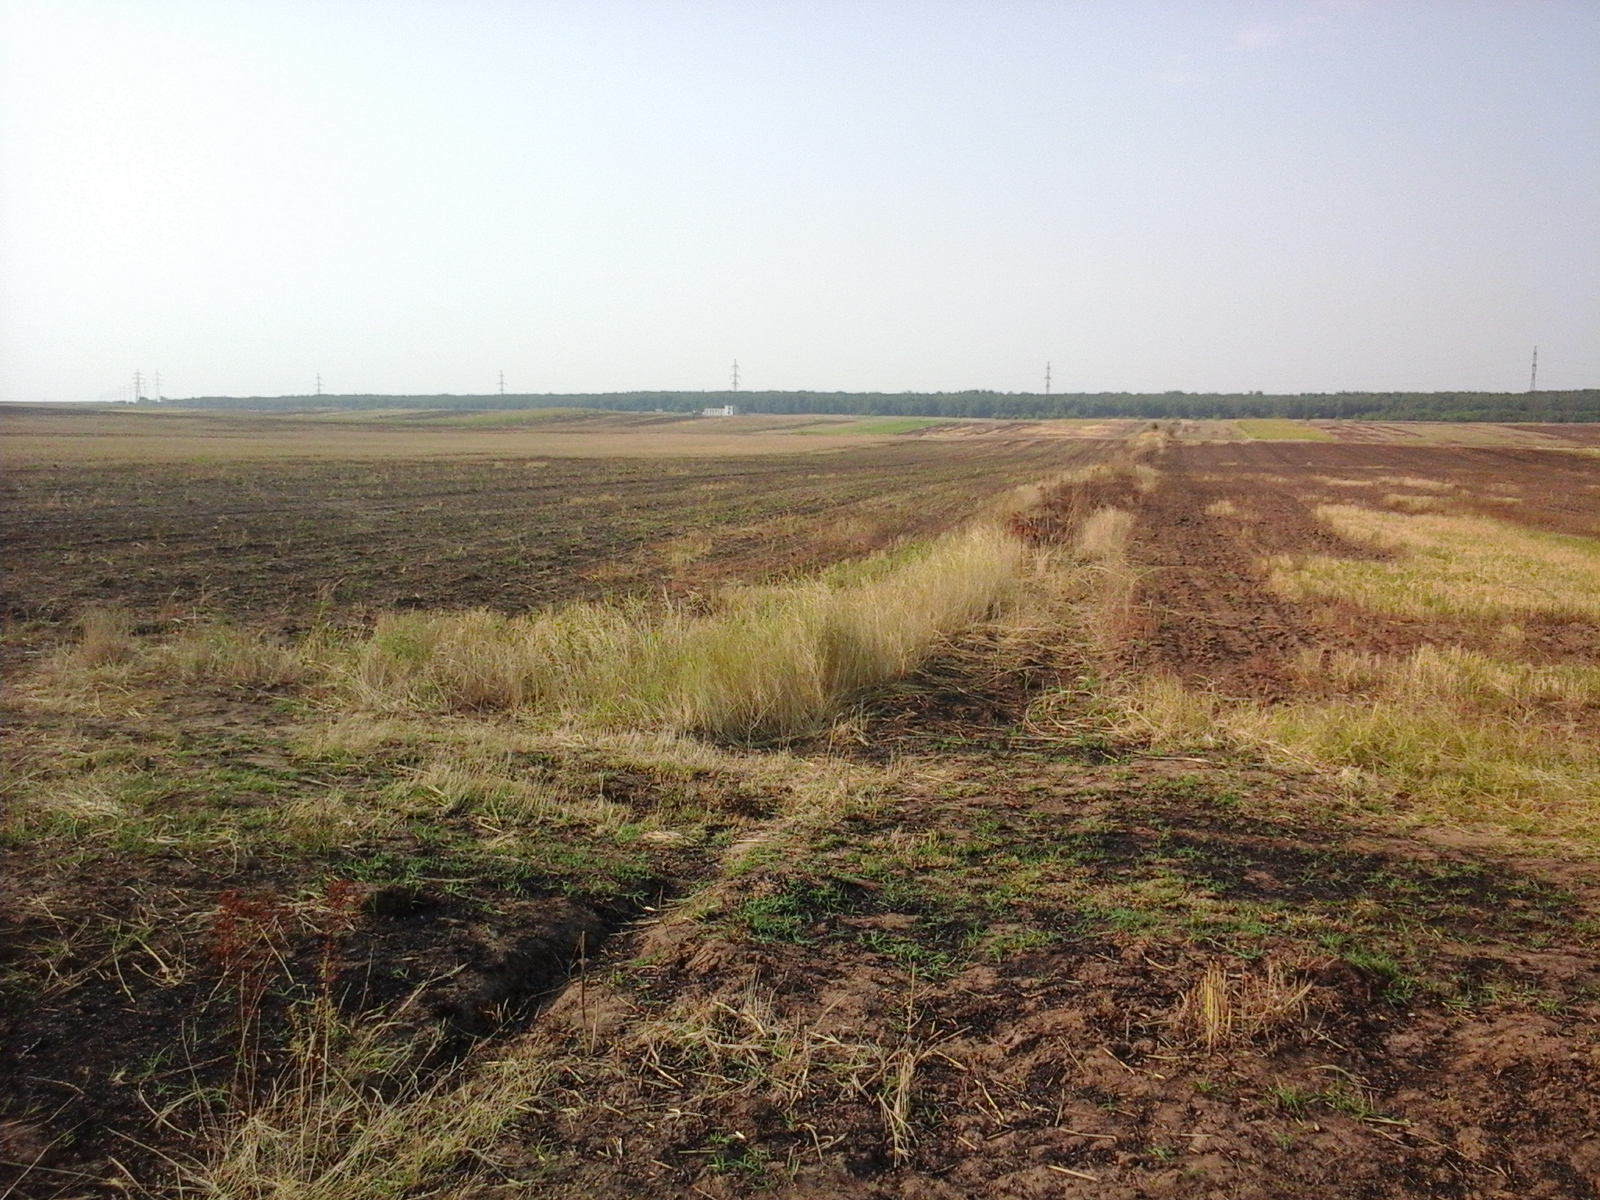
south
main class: Cropland
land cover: Barley
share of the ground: < 10 %
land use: Agriculture (excluding fallow land and kitchen gardens)
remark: Burnt area
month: August
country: RO
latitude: 44.2950
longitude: 22.7107
